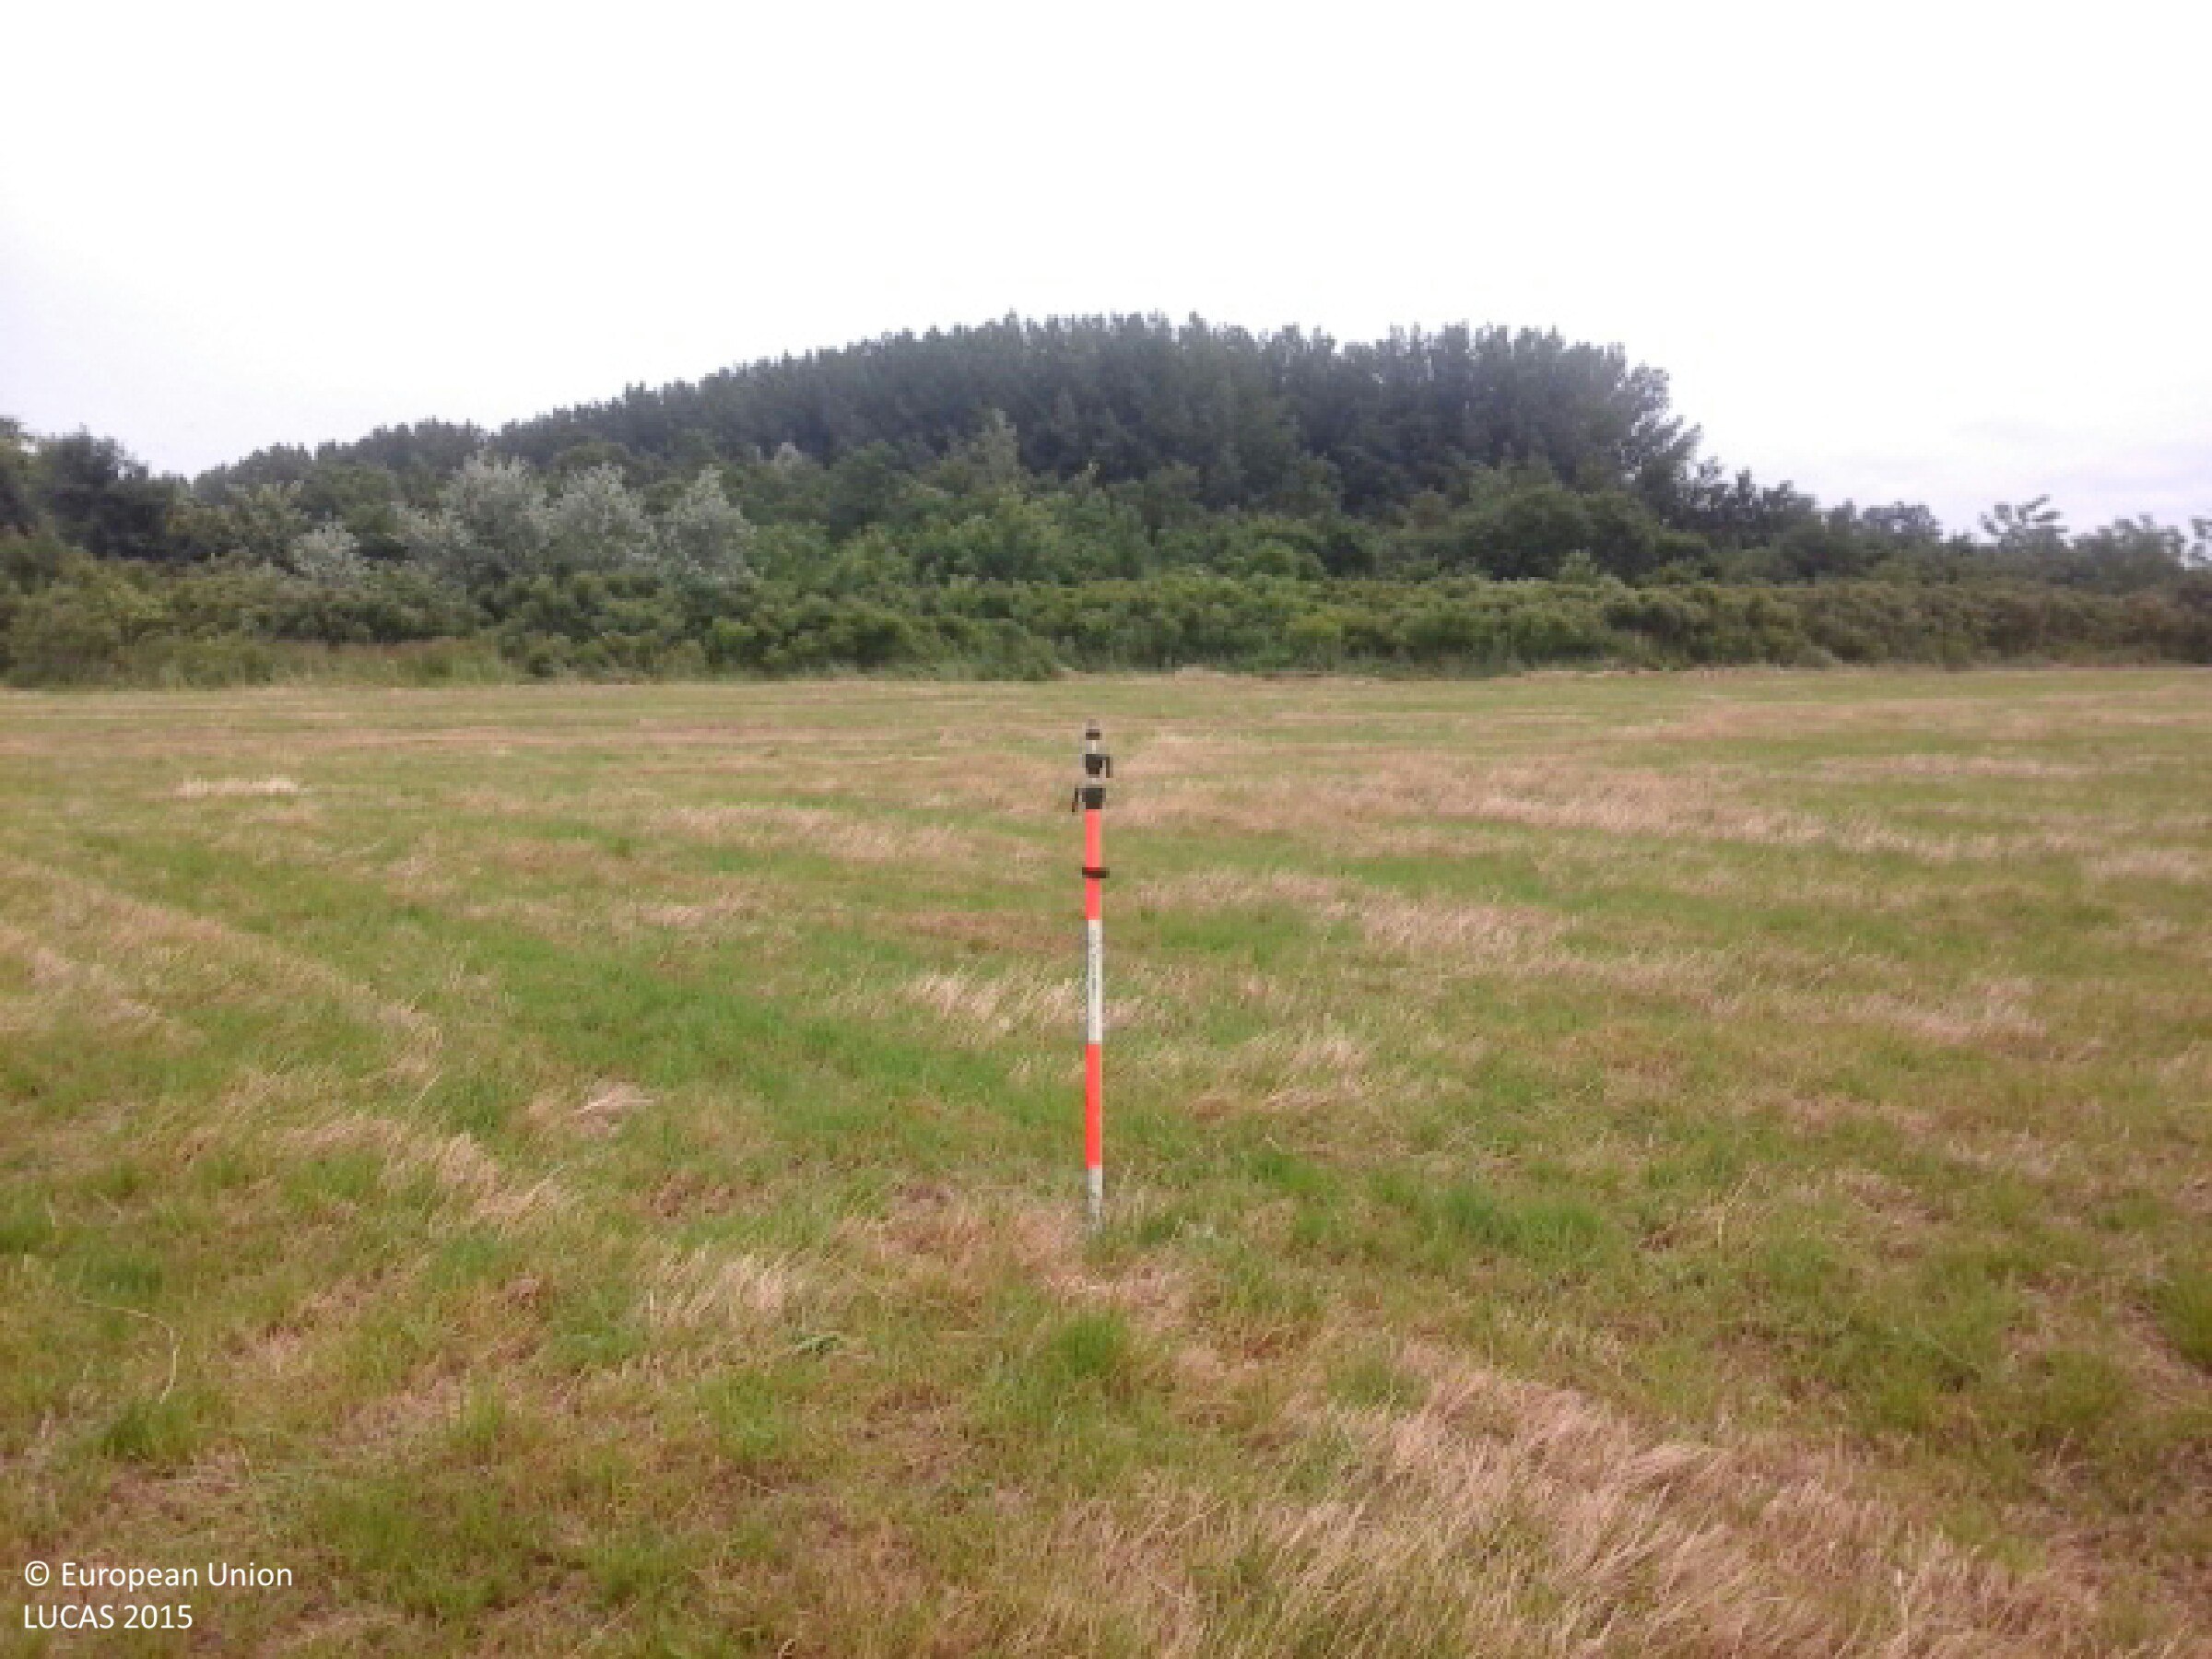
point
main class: Grassland
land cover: Grassland without tree/shrub cover
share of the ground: > 75 %
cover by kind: herbaceous plants 100 %
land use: Abandoned areas
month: June
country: HU
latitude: 48.1349
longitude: 21.7805
